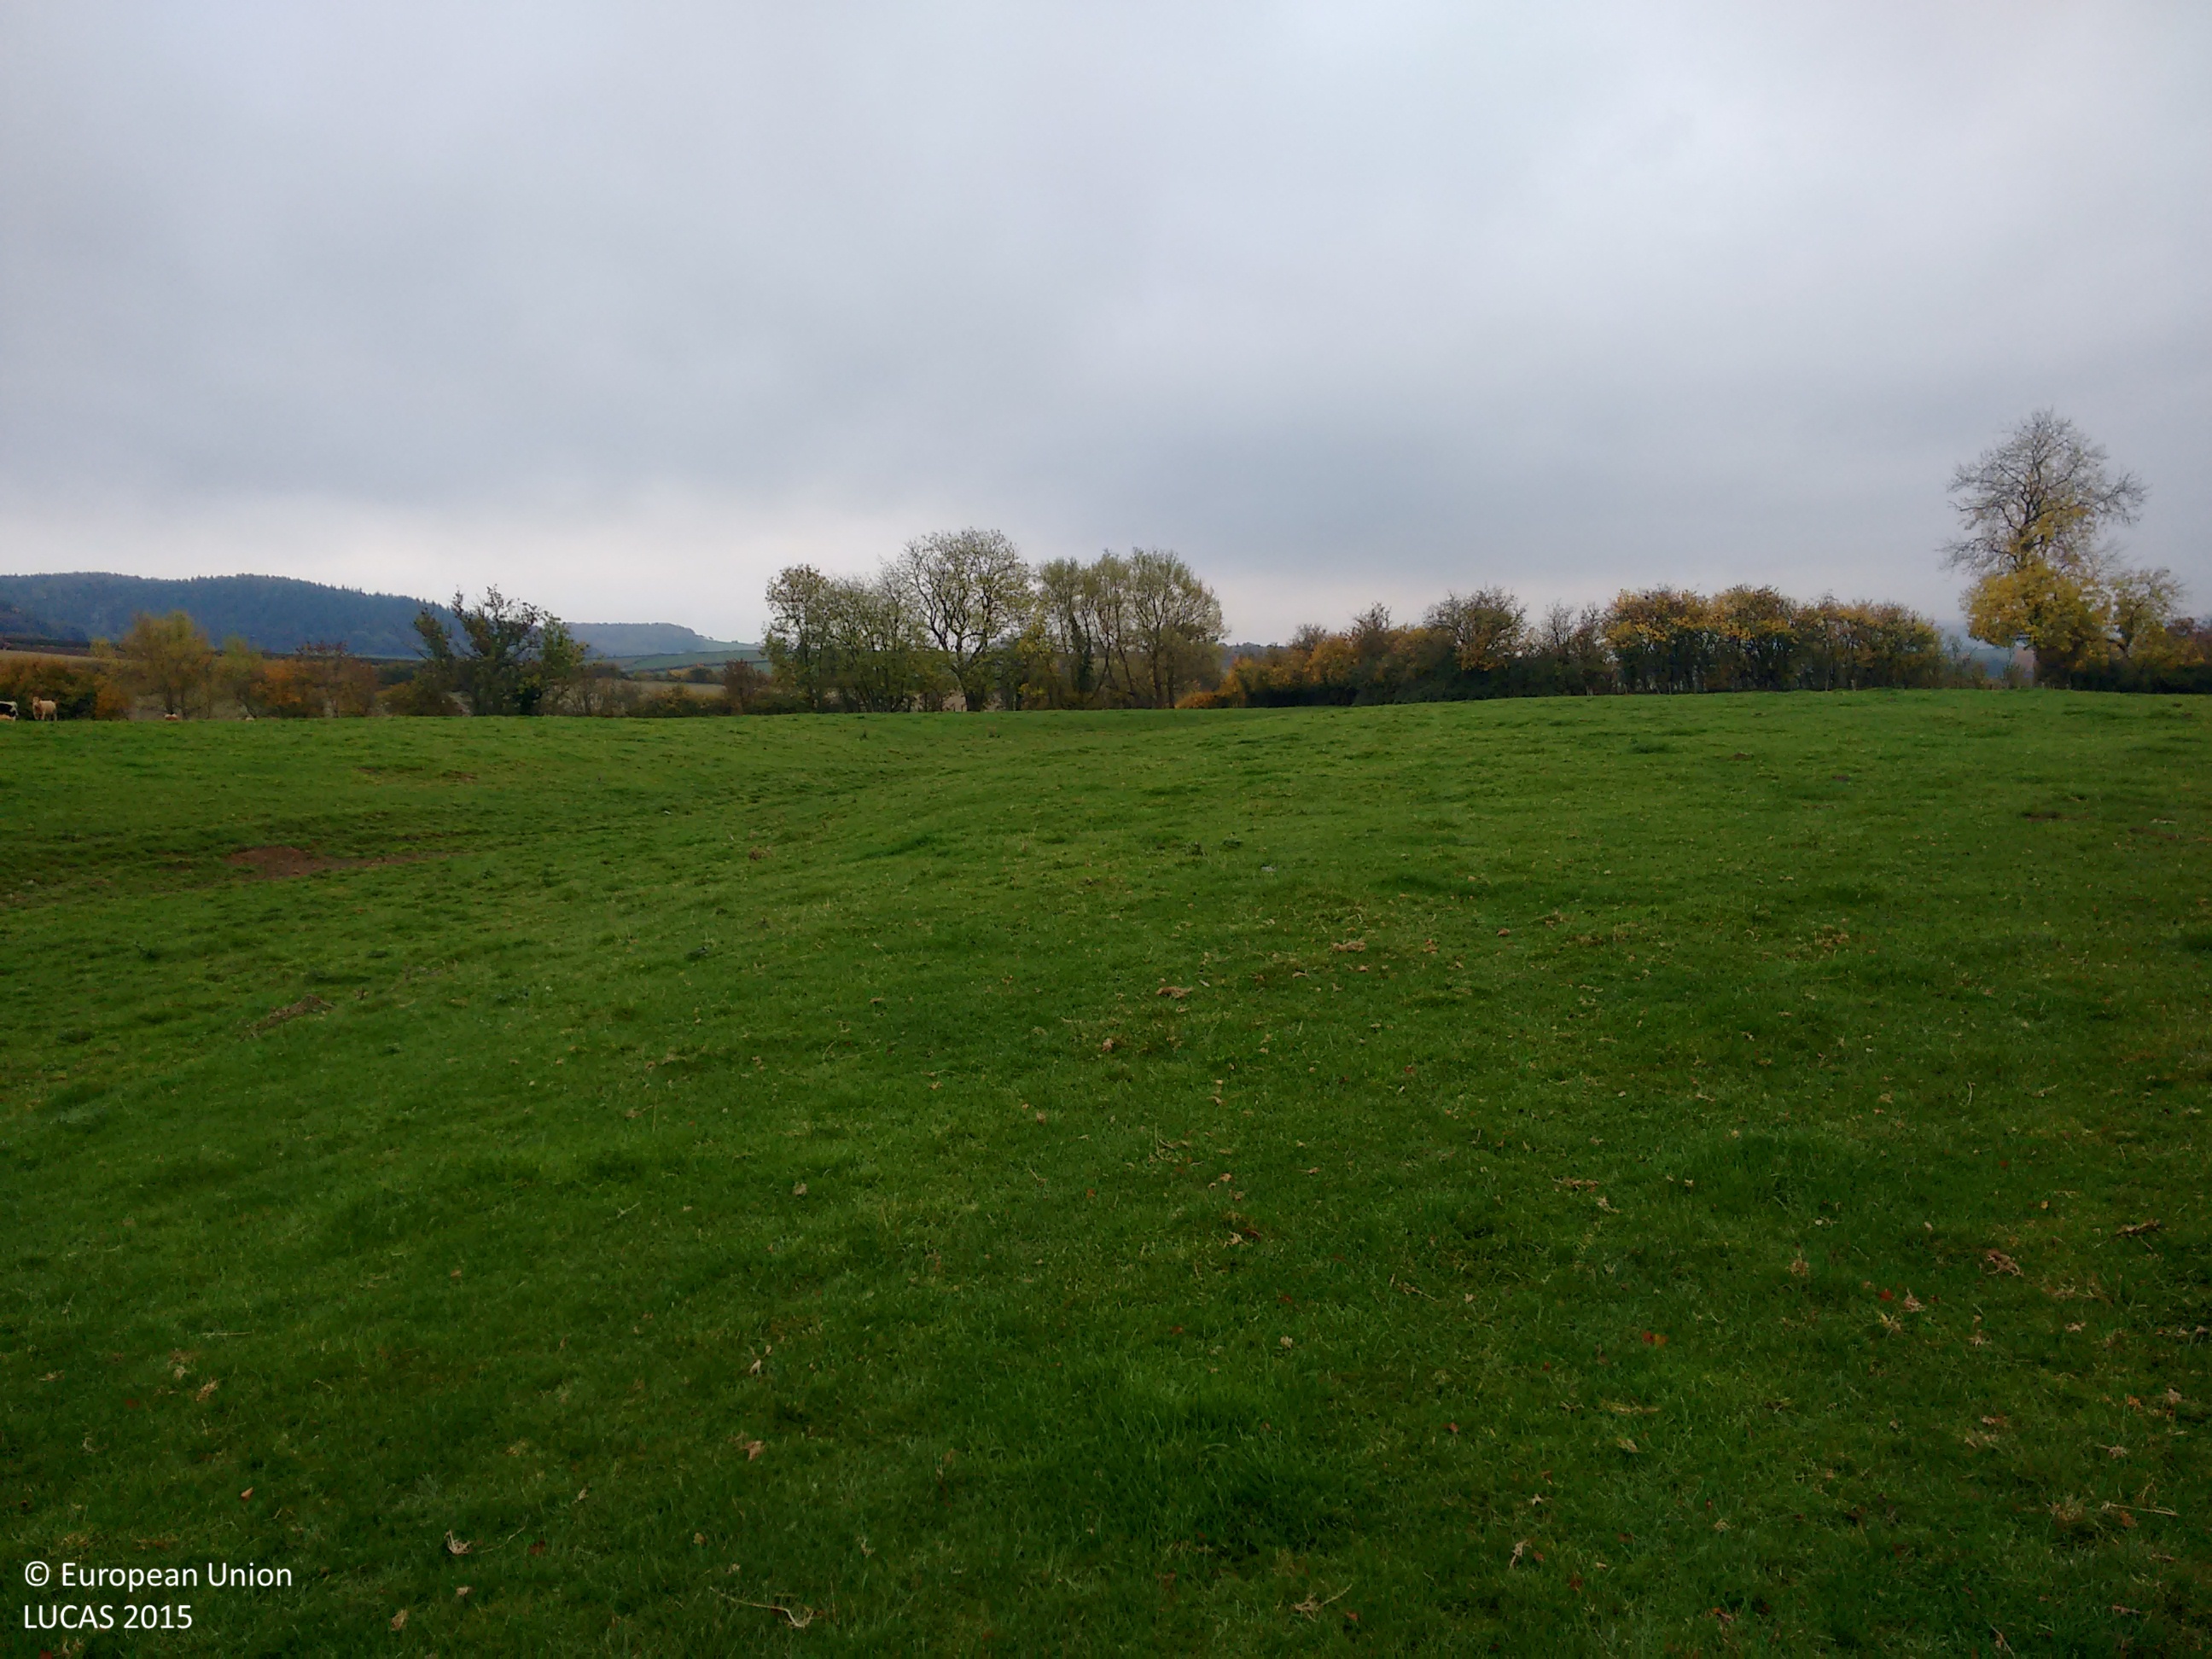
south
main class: Grassland
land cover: Grassland without tree/shrub cover
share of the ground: > 75 %
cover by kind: herbaceous plants 100 %
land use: Agriculture (excluding fallow land and kitchen gardens)
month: October
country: GB
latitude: 52.4189
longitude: -2.8798
